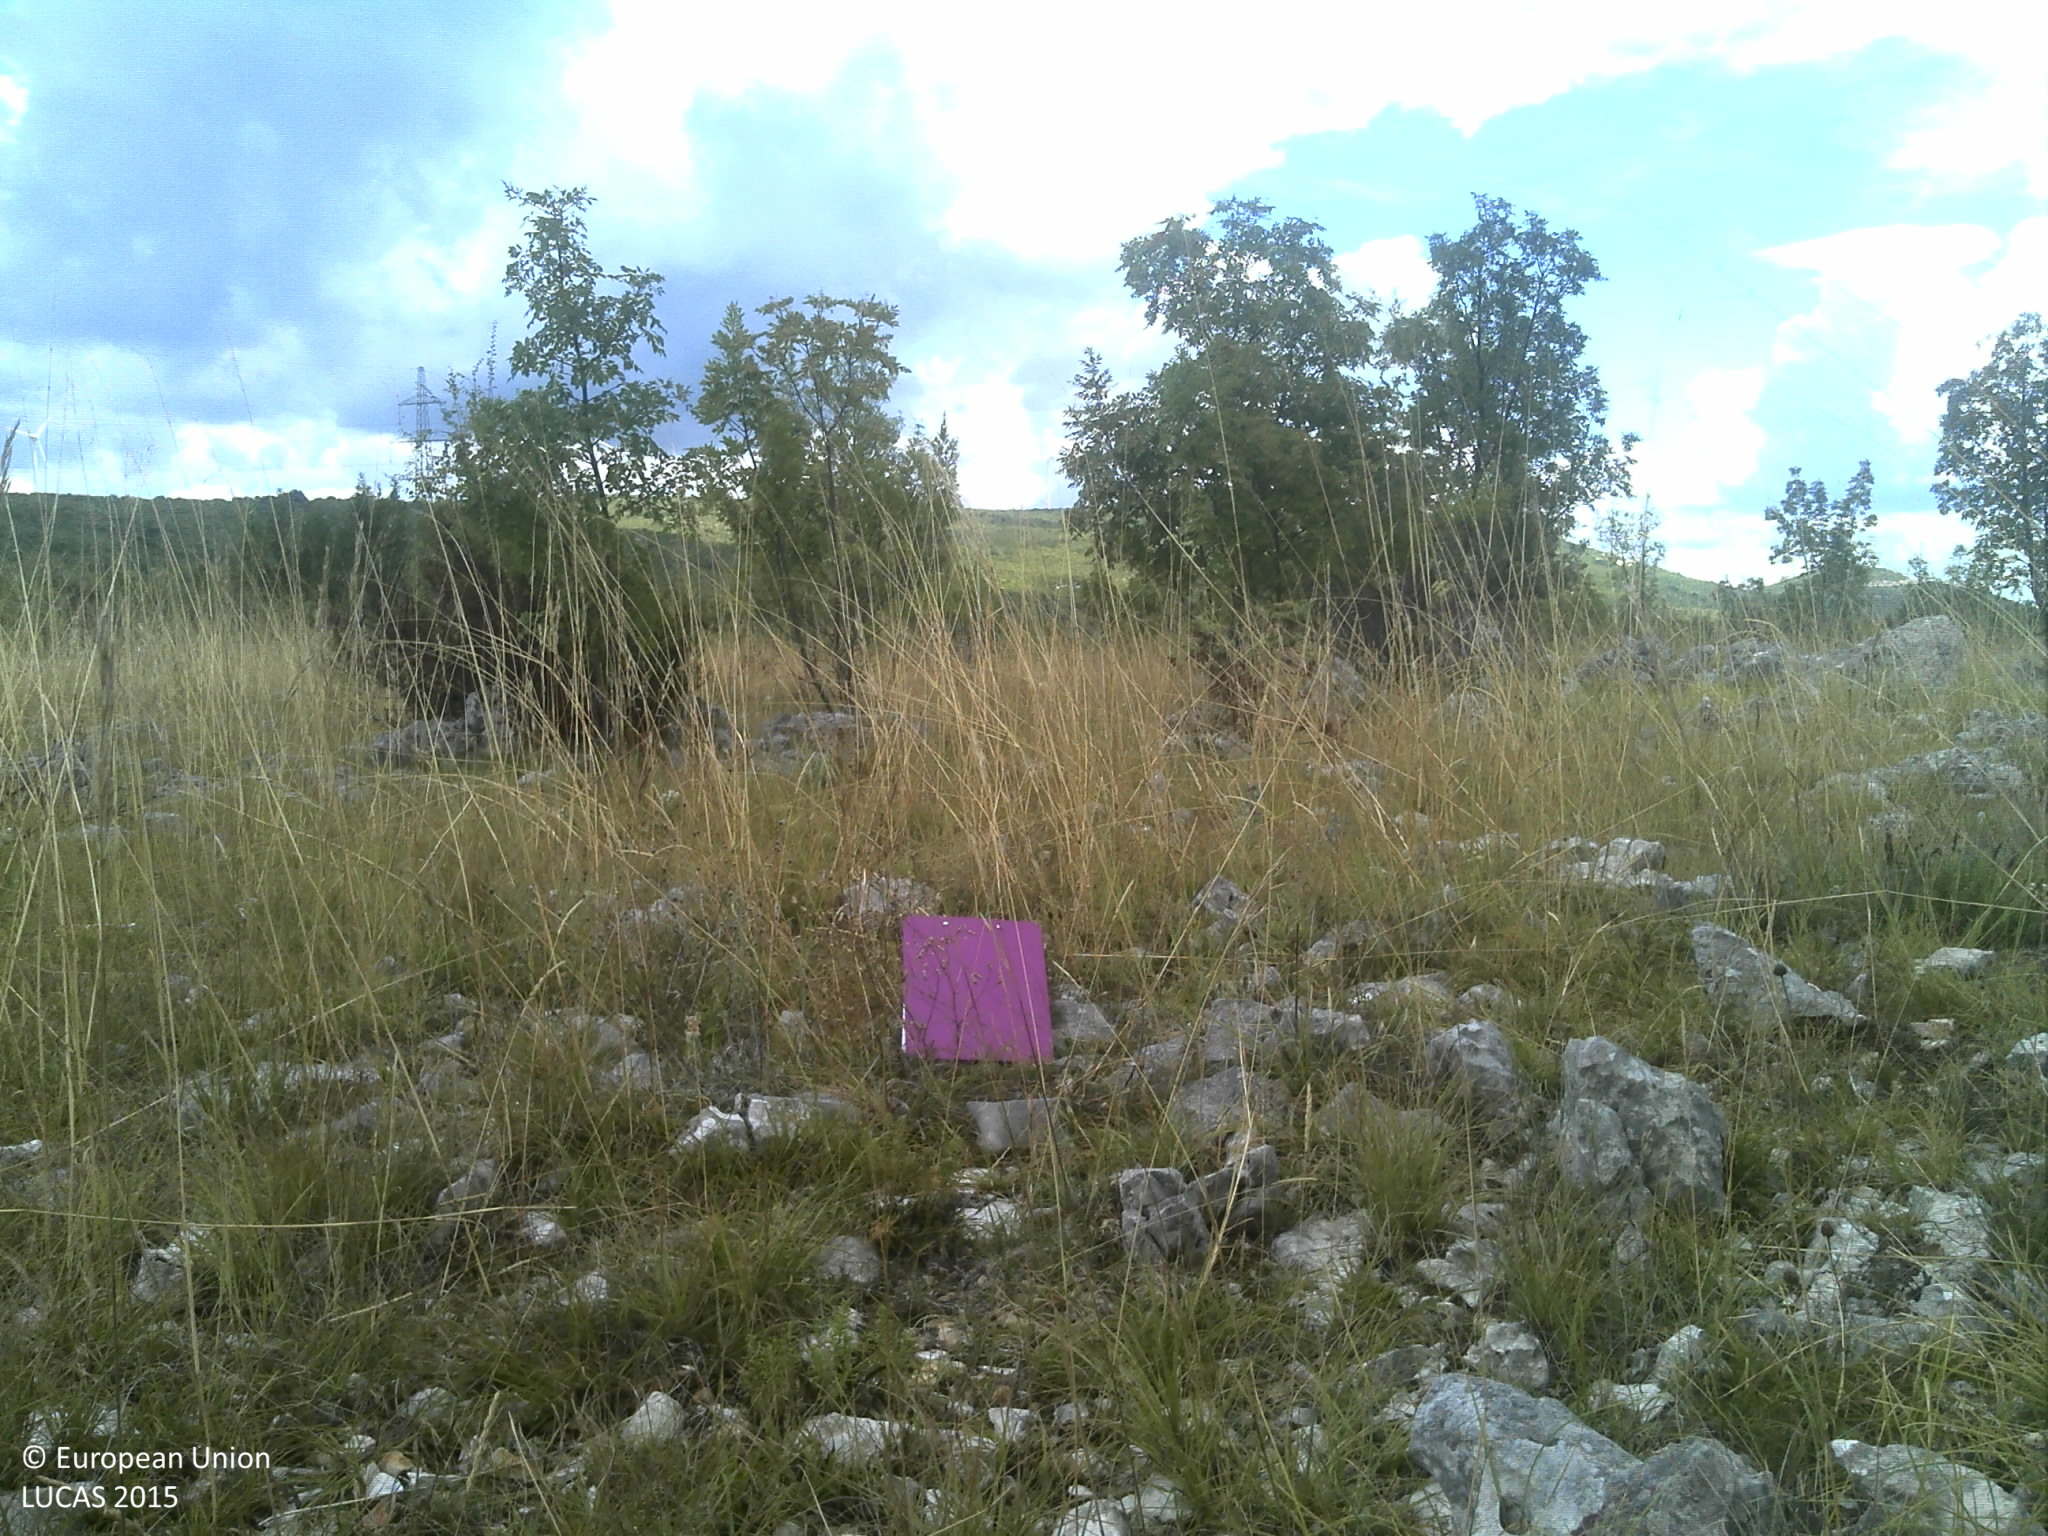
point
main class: Shrubland
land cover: Shrubland with sparse tree cover
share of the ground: 25 - 50 %
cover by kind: shrubs 35 %, herbaceous plants 30 %, unconsolidated bare surface 20 %, consolidated bare surface 10 %, broadleaved forest trees 5 %
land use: Semi-natural and natural areas not in use
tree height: < 5 m
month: August
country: HR
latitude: 43.6073
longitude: 16.4461
